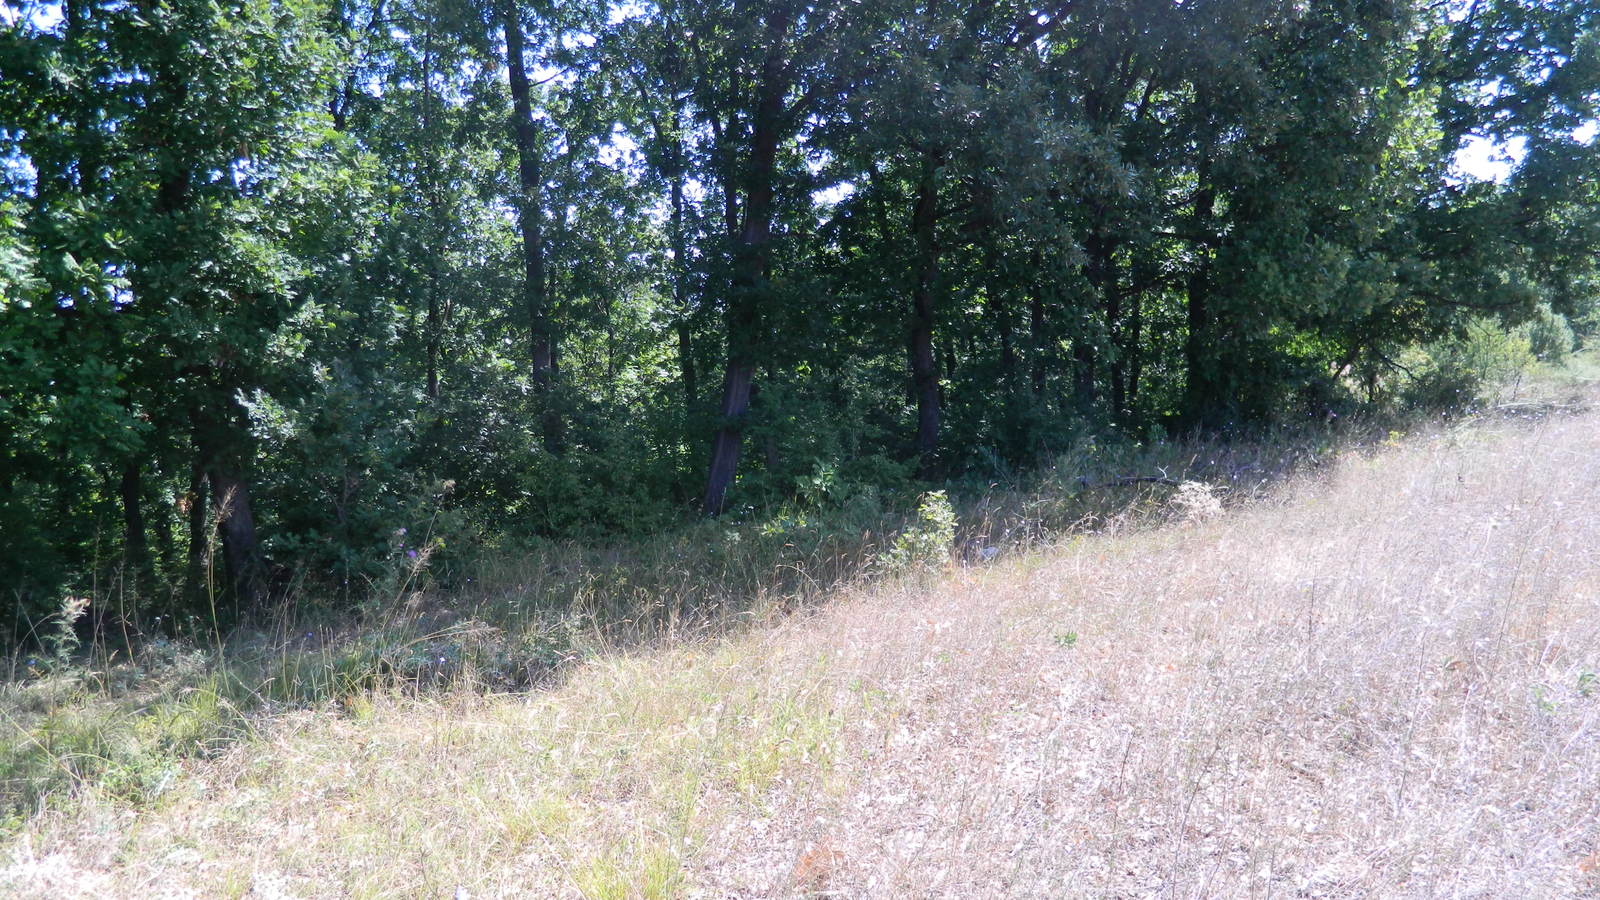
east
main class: Woodland
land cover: Broadleaved woodland
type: mesophytic deciduous forest
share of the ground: > 75 %
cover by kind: broadleaved forest trees 95 %, shrubs 5 %
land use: Forestry
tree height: > 5 m
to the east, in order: Broadleaved woodland; Tracks; Broadleaved woodland; Rivers and streams; Broadleaved woodland
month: August
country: BG
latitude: 41.6893
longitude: 25.7439
